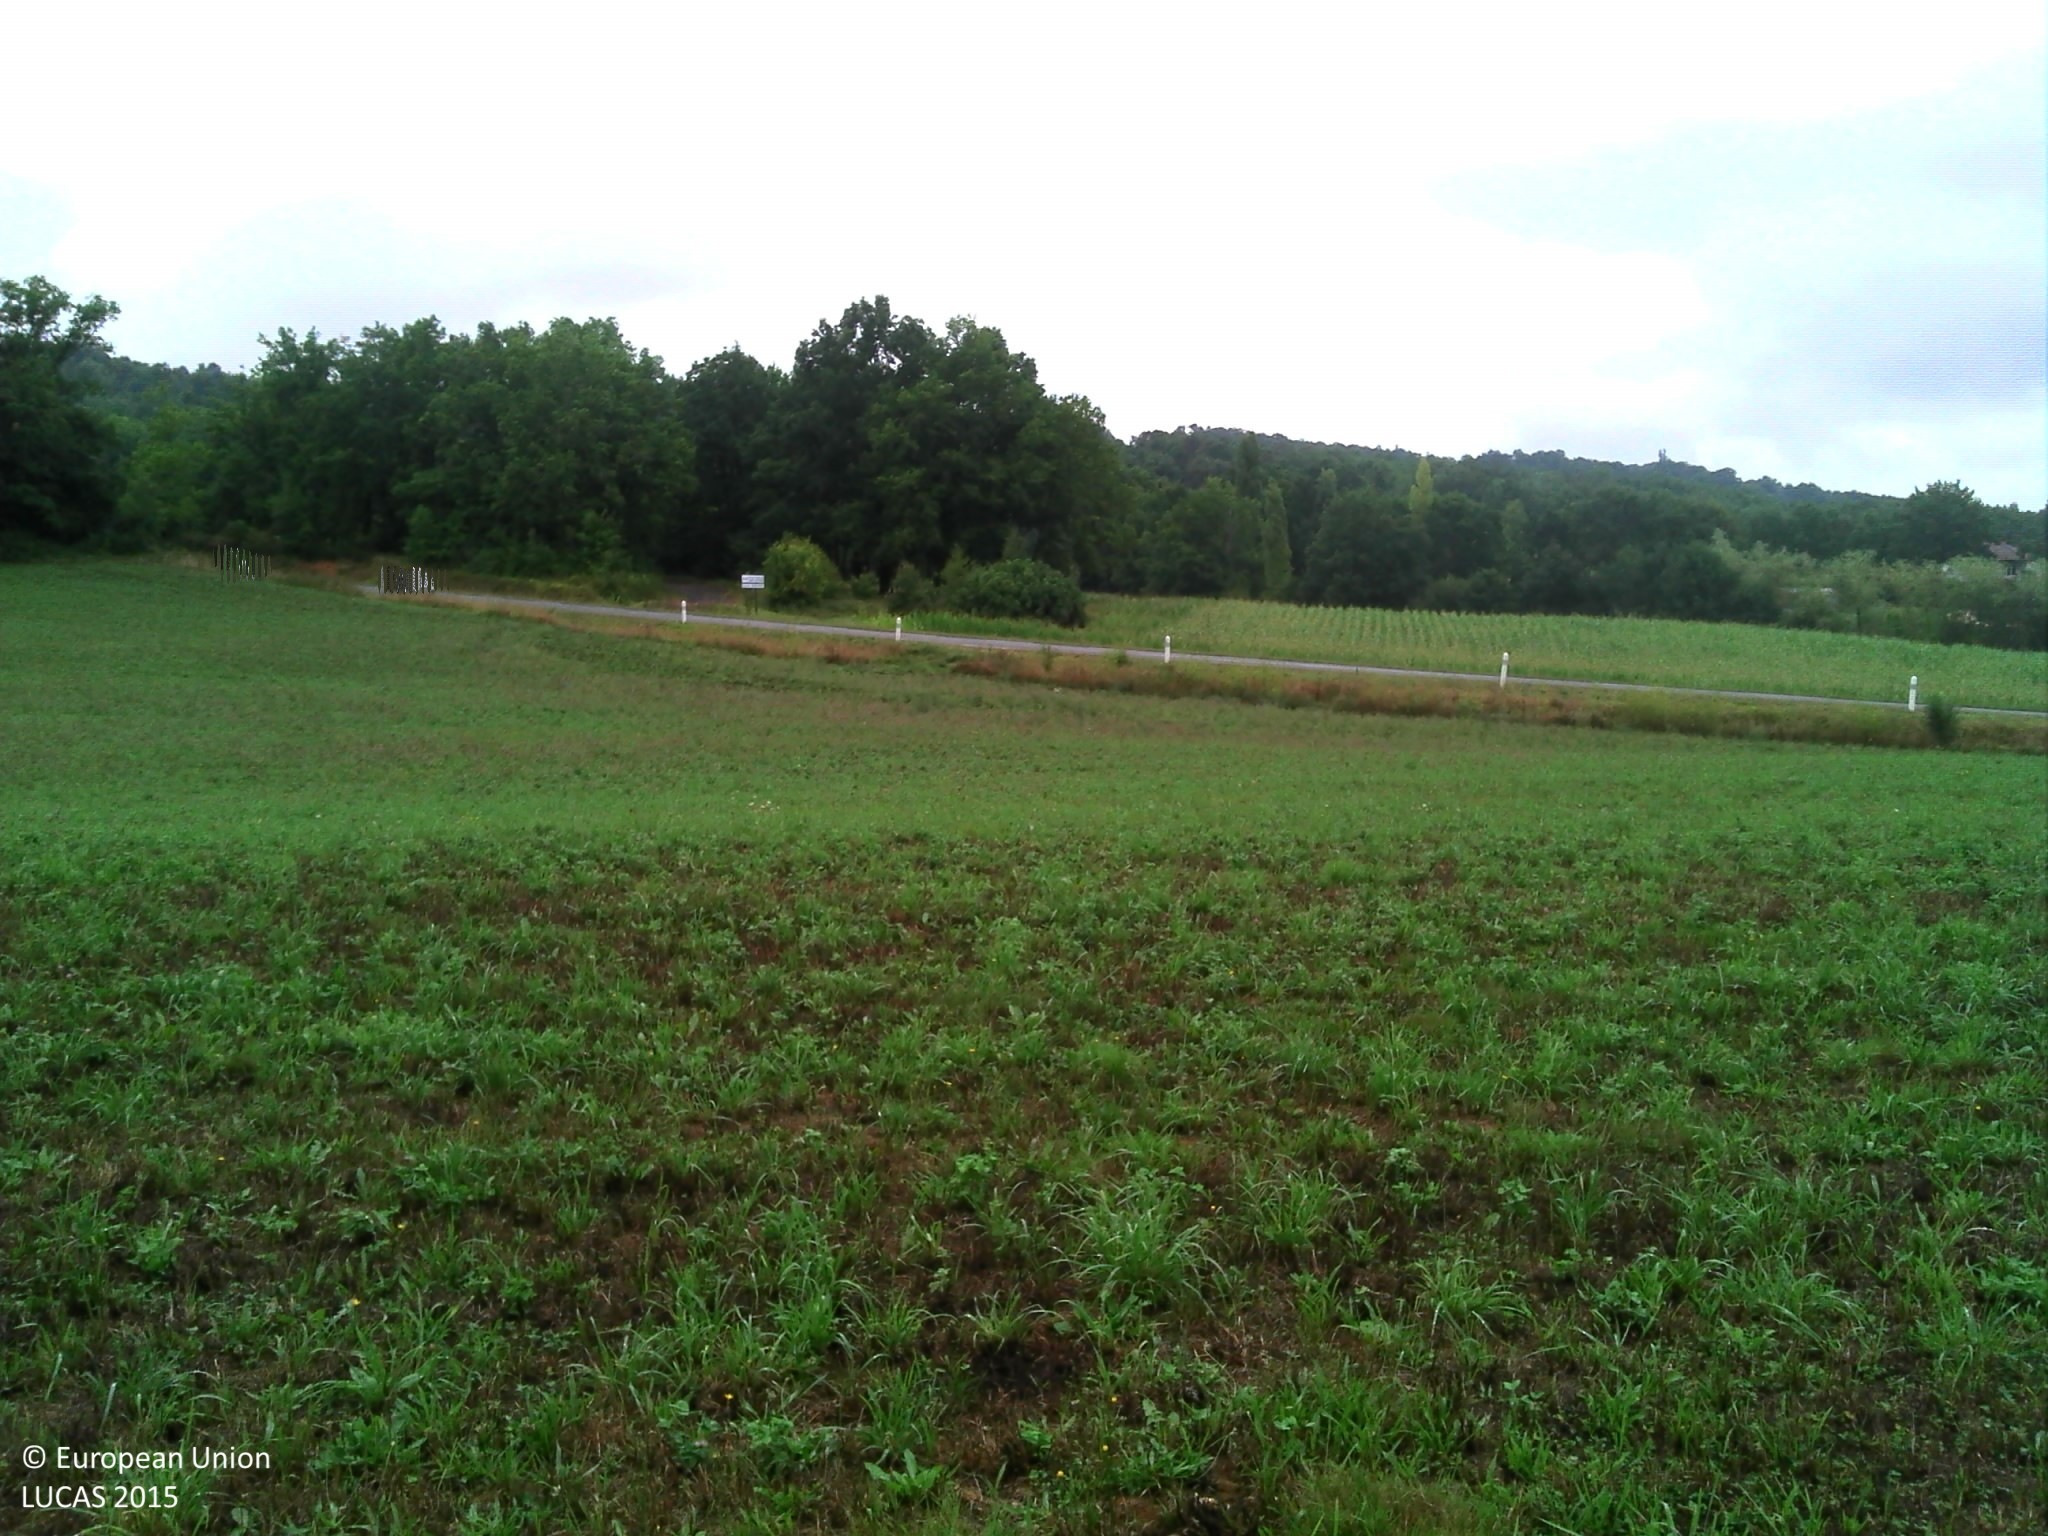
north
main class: Cropland
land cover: Temporary grasslands
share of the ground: 50 - 75 %
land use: Agriculture (excluding fallow land and kitchen gardens)
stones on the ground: < 10 %
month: August
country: FR
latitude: 45.4953
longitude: 0.7369
